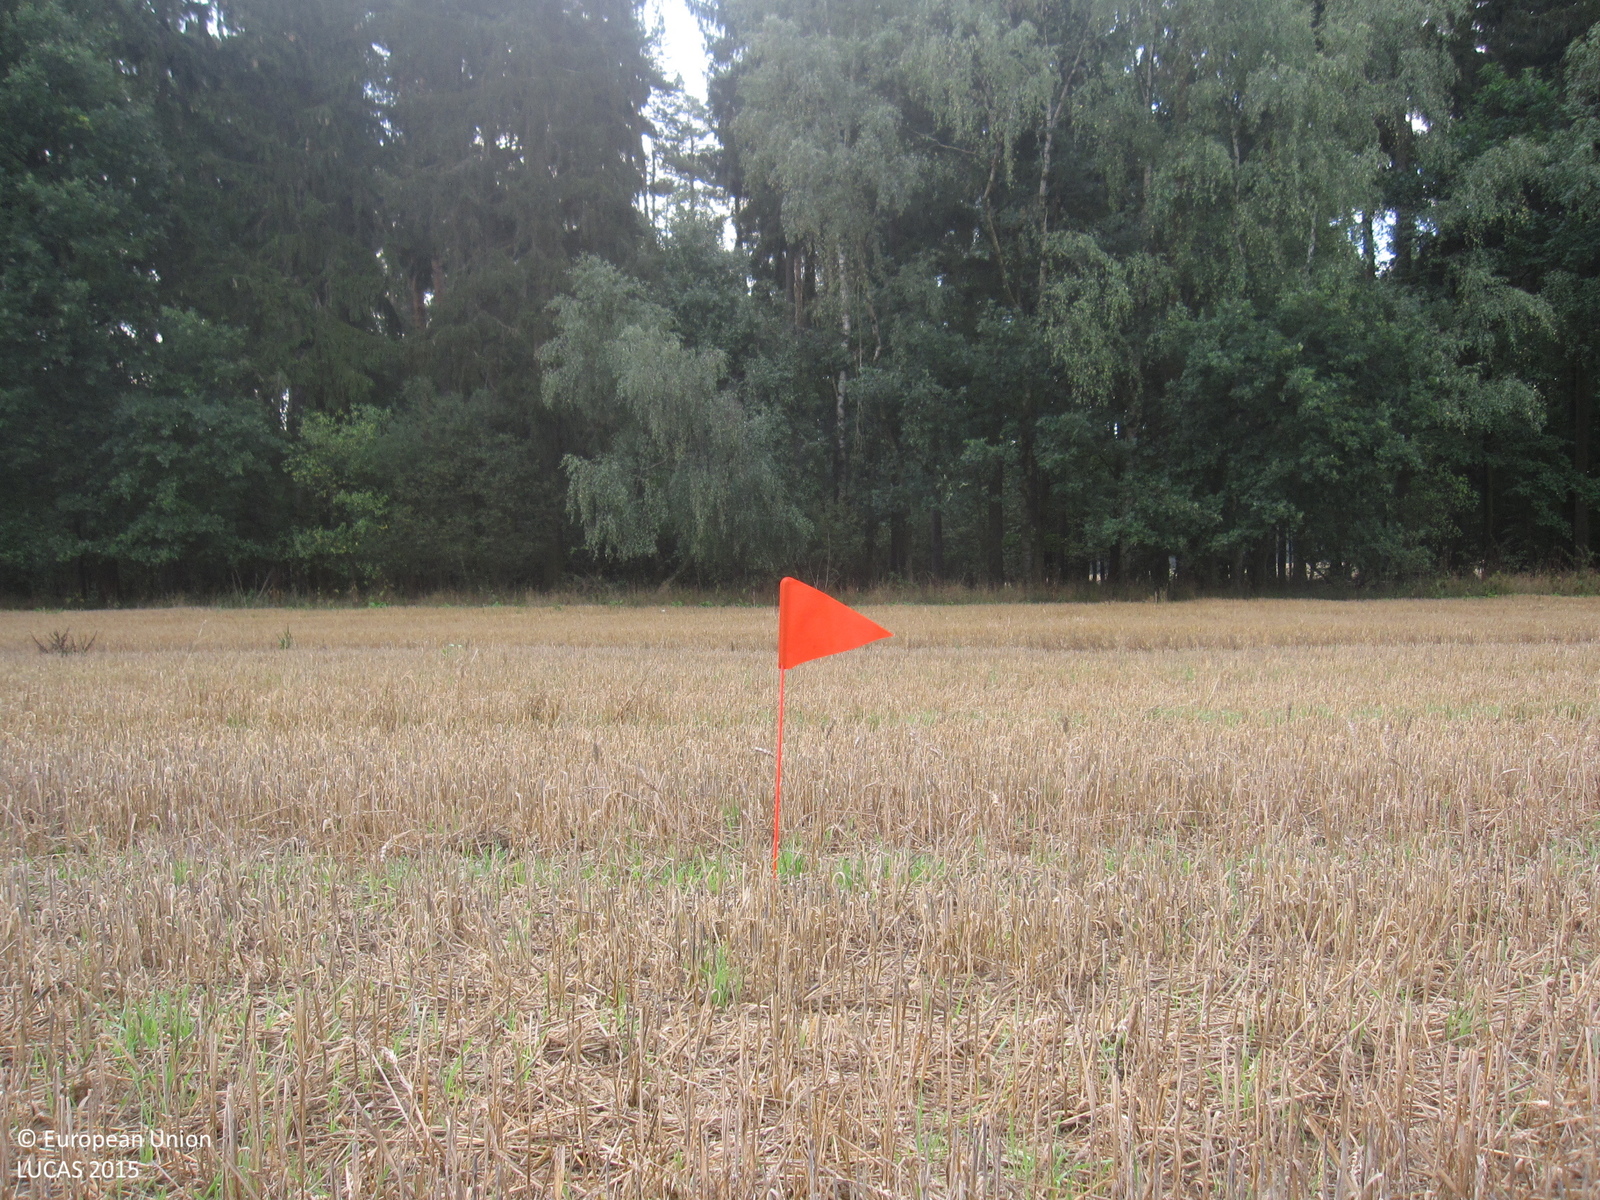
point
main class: Cropland
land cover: Common wheat
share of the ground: 50 - 75 %
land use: Agriculture (excluding fallow land and kitchen gardens)
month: August
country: DE
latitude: 50.7962
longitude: 12.0001
